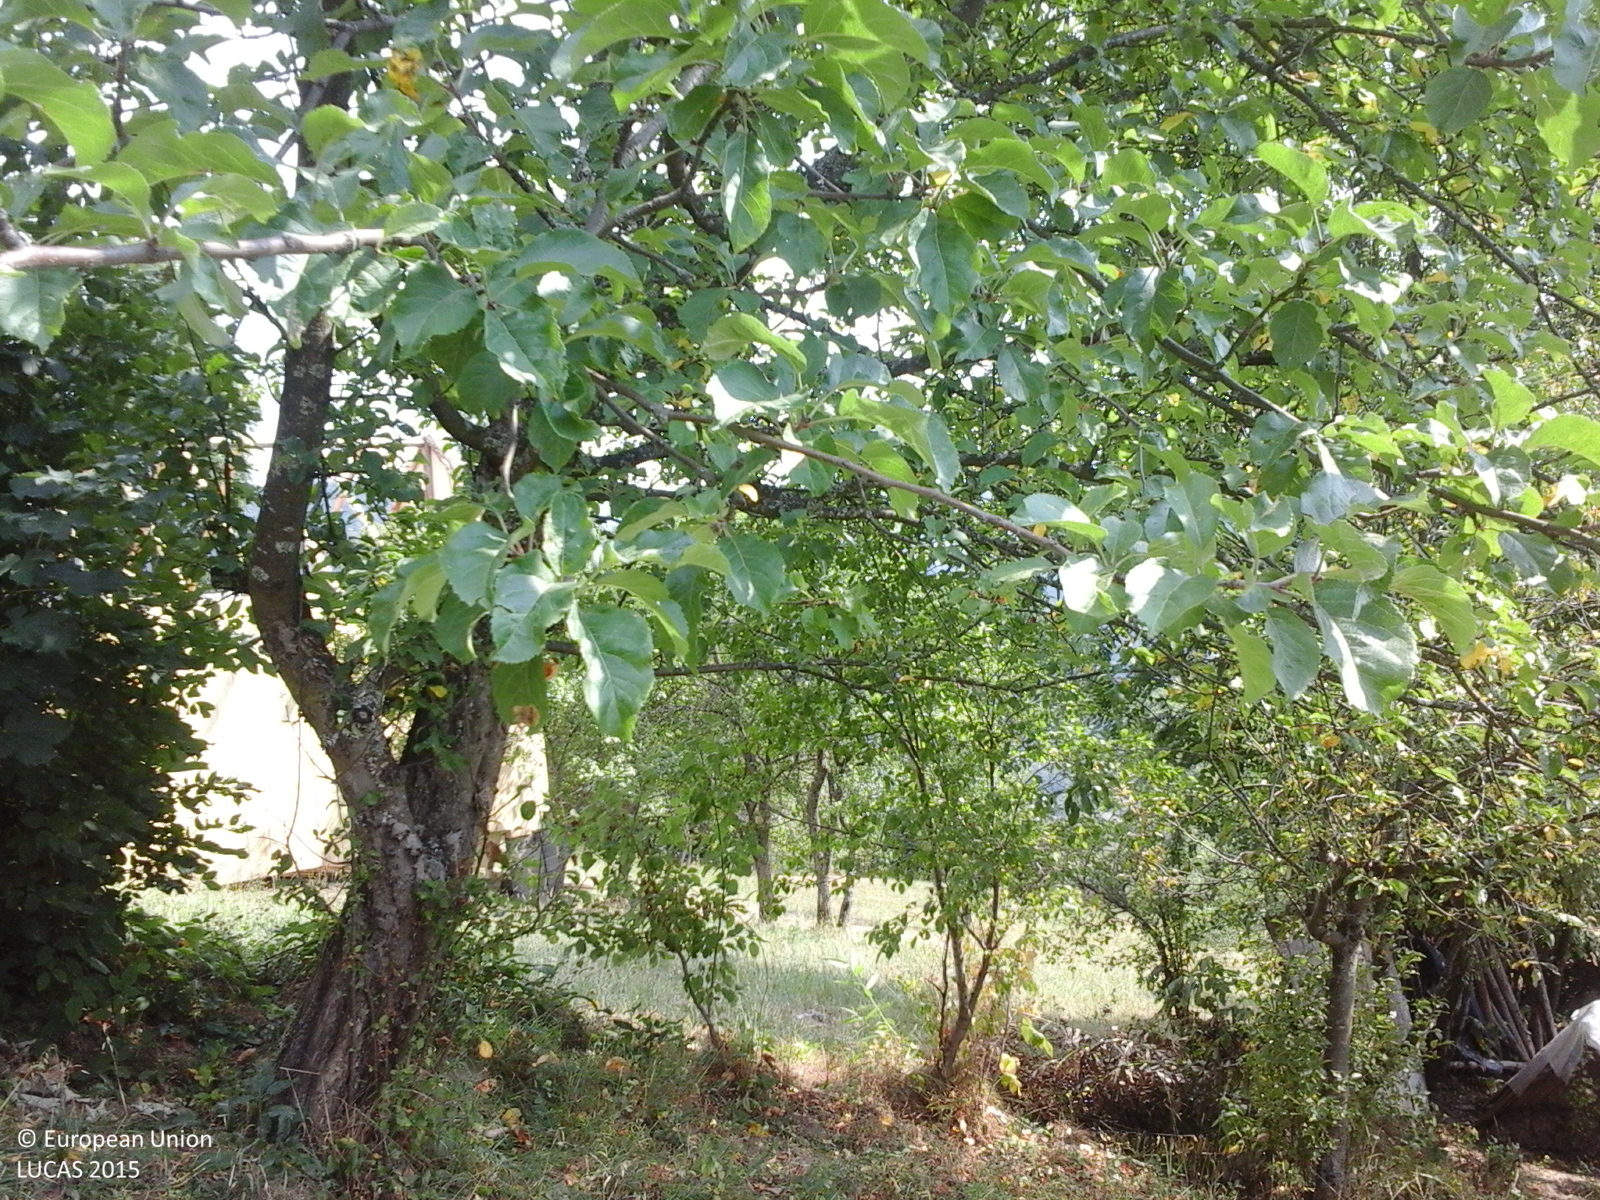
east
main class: Cropland
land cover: Apple fruit
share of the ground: 10 - 25 %
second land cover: Grassland without tree/shrub cover
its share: > 75 %
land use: Agriculture (excluding fallow land and kitchen gardens)
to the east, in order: Apple fruit; Grassland without tree/shrub cover; Artificial constructions in urban areas; Grassland without tree/shrub cover; Abandoned hedges; Grassland without tree/shrub cover; Abandoned hedges; Grassland with sparse tree/shrub cover; Grassland without tree/shrub cover
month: September
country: RO
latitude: 47.8521
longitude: 24.4344
